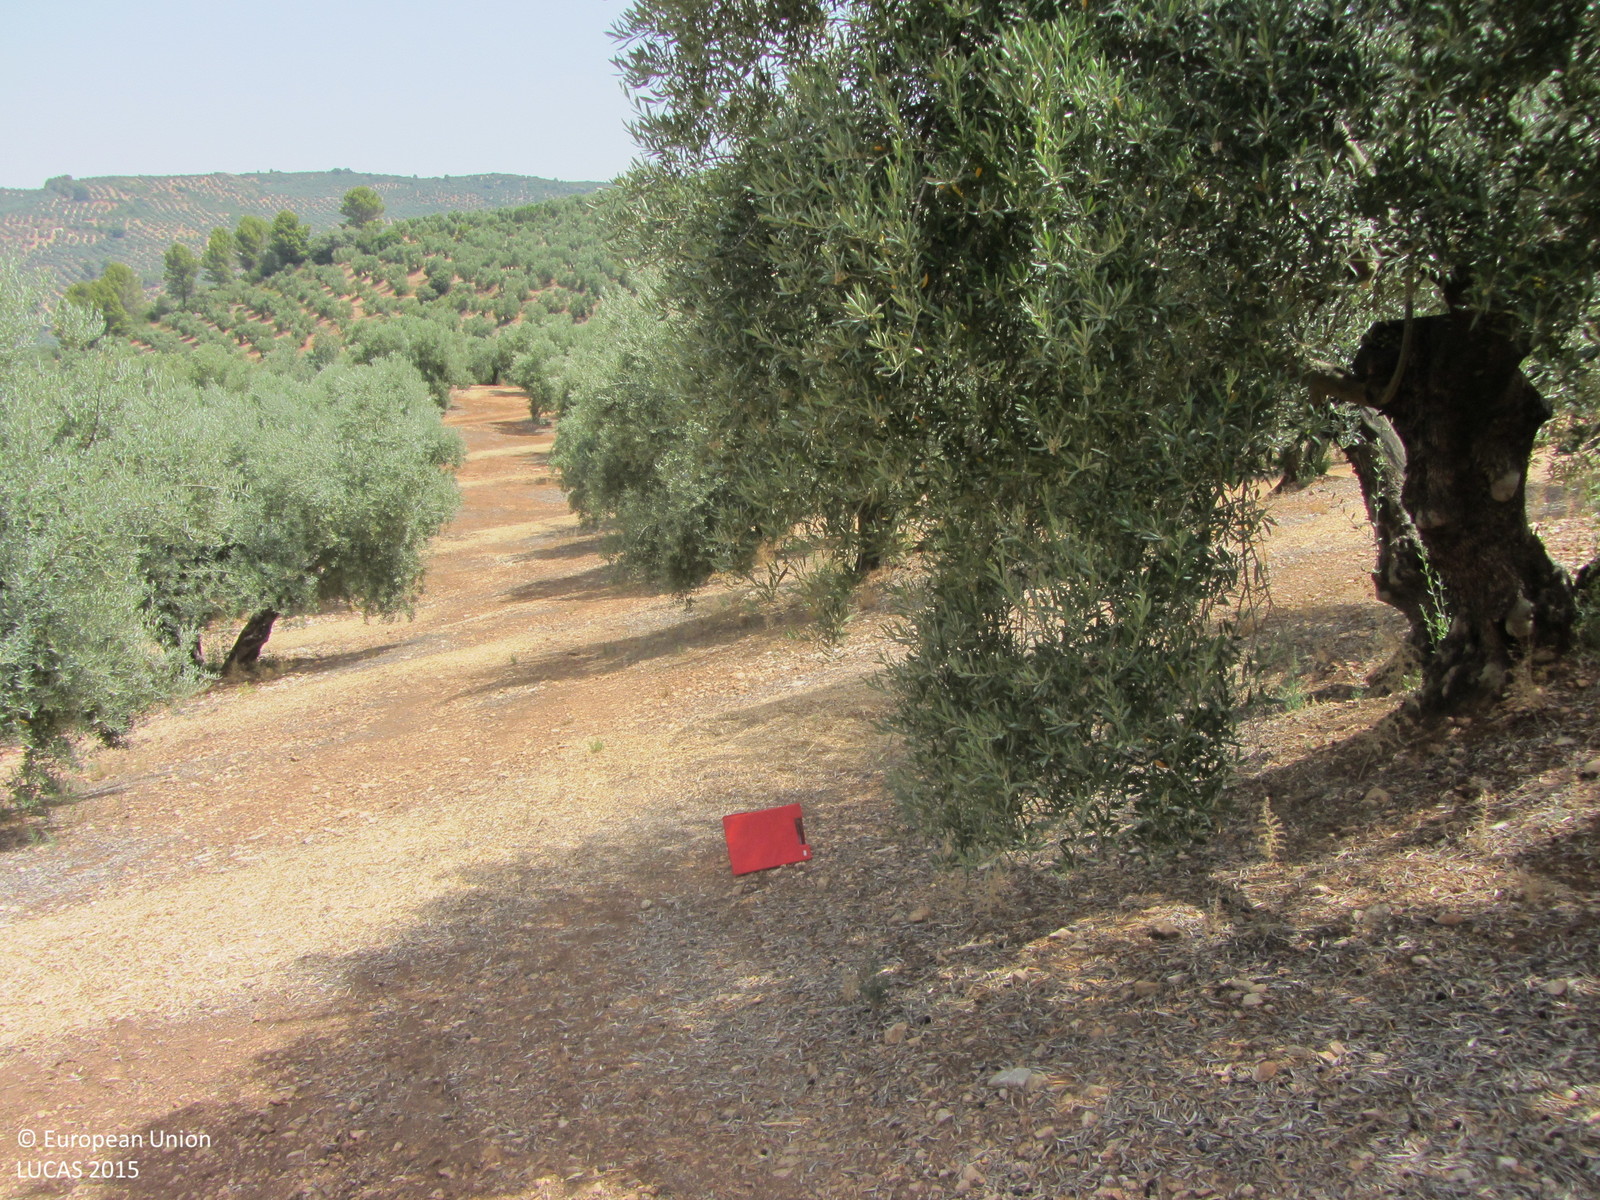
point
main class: Cropland
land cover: Olive groves
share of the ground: 25 - 50 %
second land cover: Other bare soil
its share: > 75 %
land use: Agriculture (excluding fallow land and kitchen gardens)
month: July
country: ES
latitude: 38.2998
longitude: -2.8635
